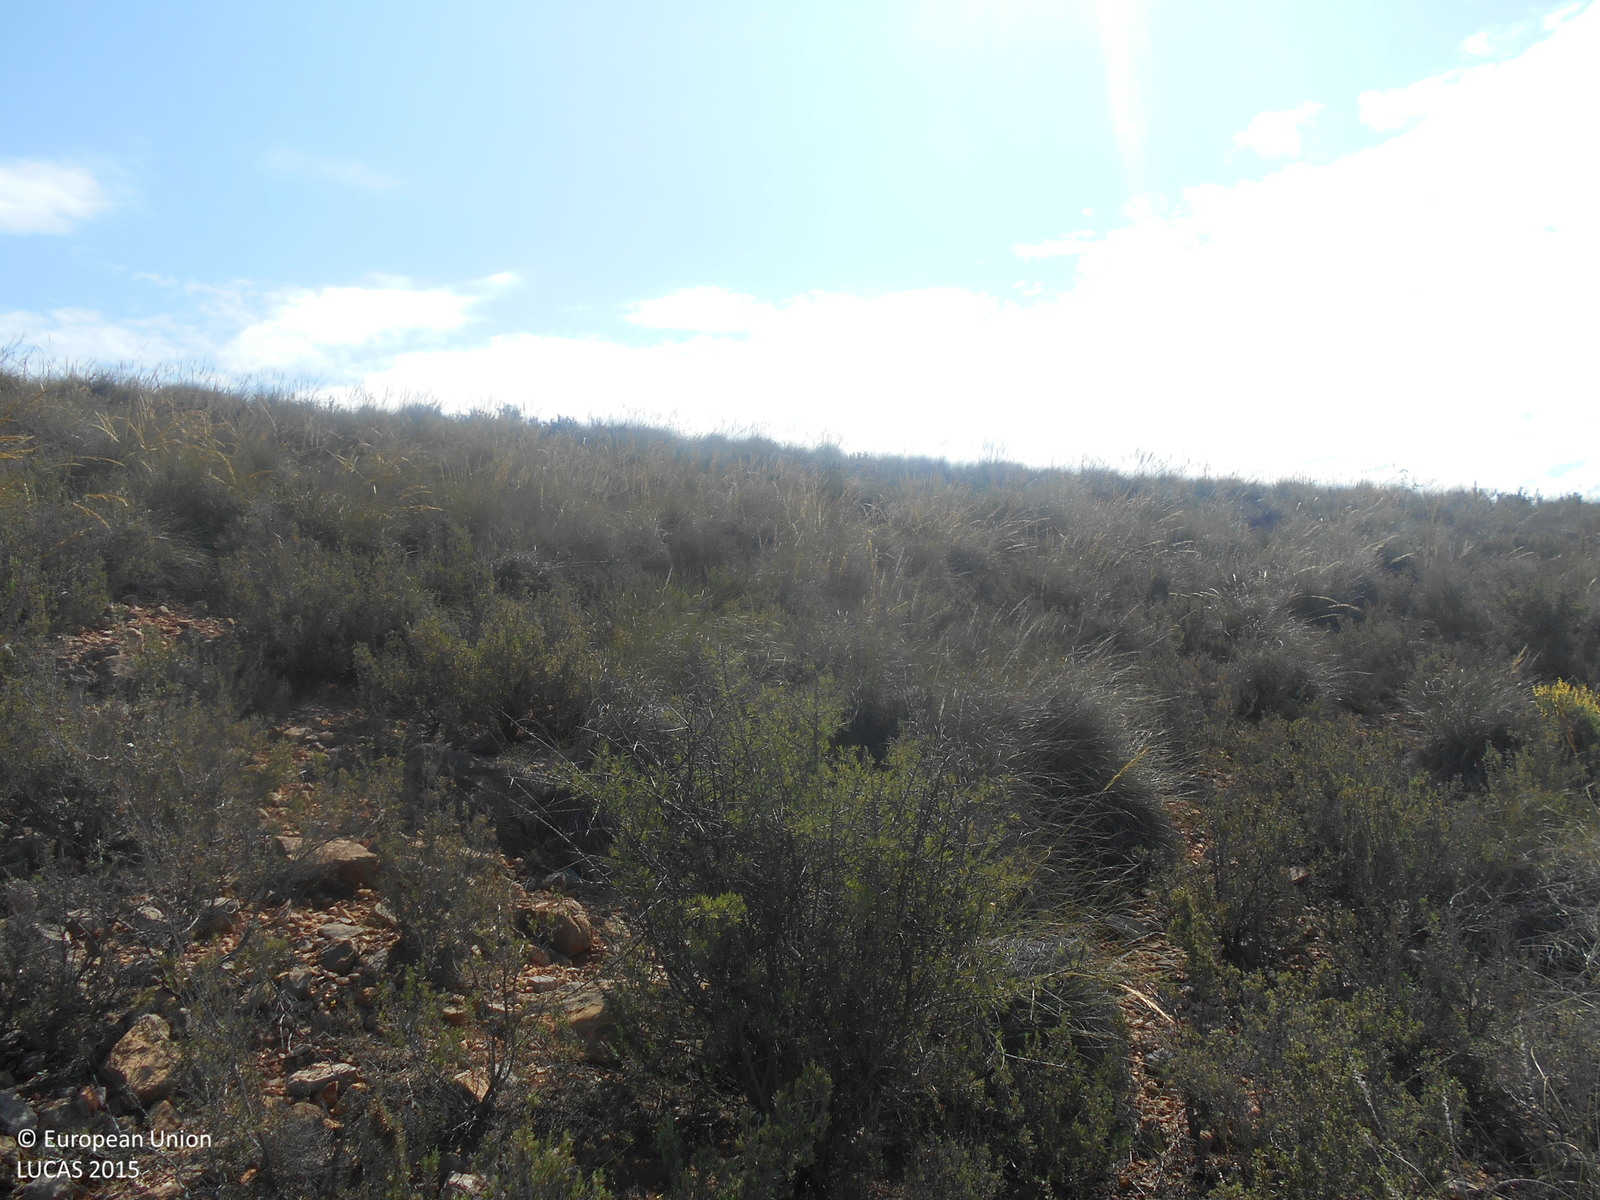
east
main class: Shrubland
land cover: Shrubland without tree cover
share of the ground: > 75 %
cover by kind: shrubs 80 %, unconsolidated bare surface 15 %, consolidated bare surface 5 %
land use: Semi-natural and natural areas not in use
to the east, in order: Shrubland without tree cover; Rivers and streams; Shrubland without tree cover; Pine dominated coniferous woodland
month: April
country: ES
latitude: 37.8001
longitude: -1.3282
